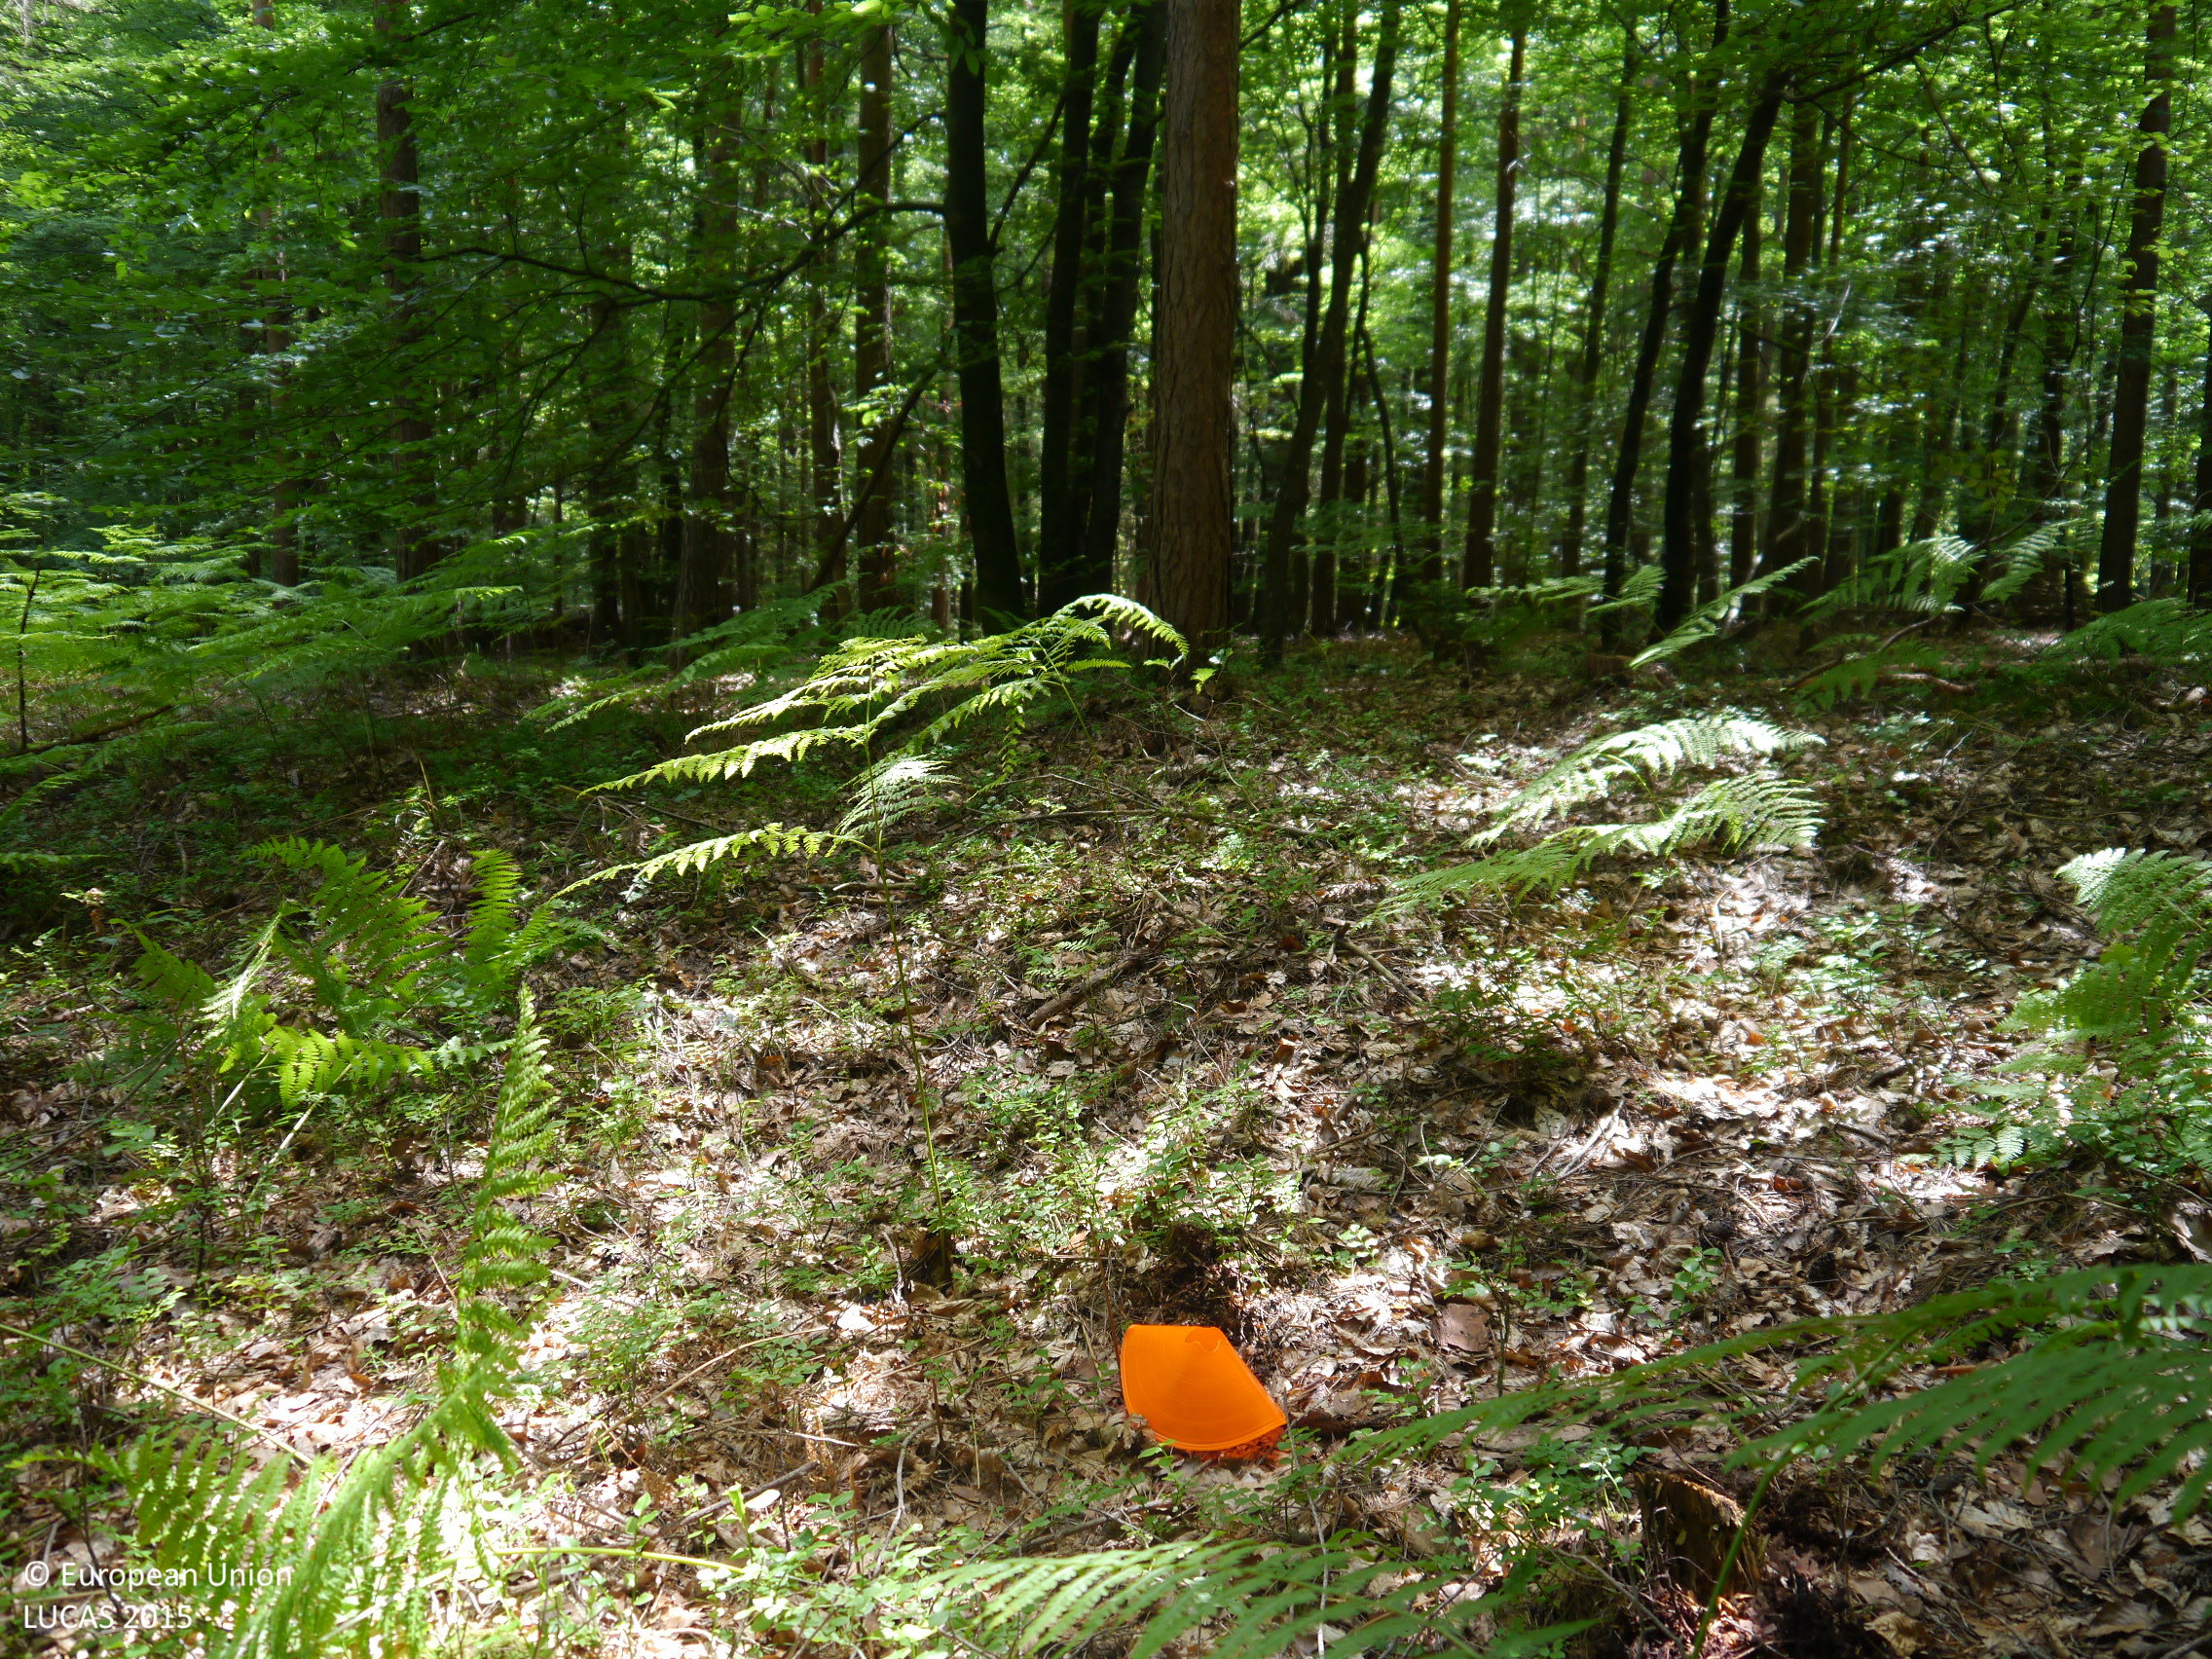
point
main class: Woodland
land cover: Pine dominated mixed woodland
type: hemiboreal forest and nemoral coniferous forest and mixed broadleaved-coniferous forest
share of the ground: > 75 %
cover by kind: broadleaved forest trees 50 %, coniferous forest trees 45 %, herbaceous plants 5 %
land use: Forestry
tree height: > 5 m
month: June
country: AT
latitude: 46.8668
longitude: 15.7066
